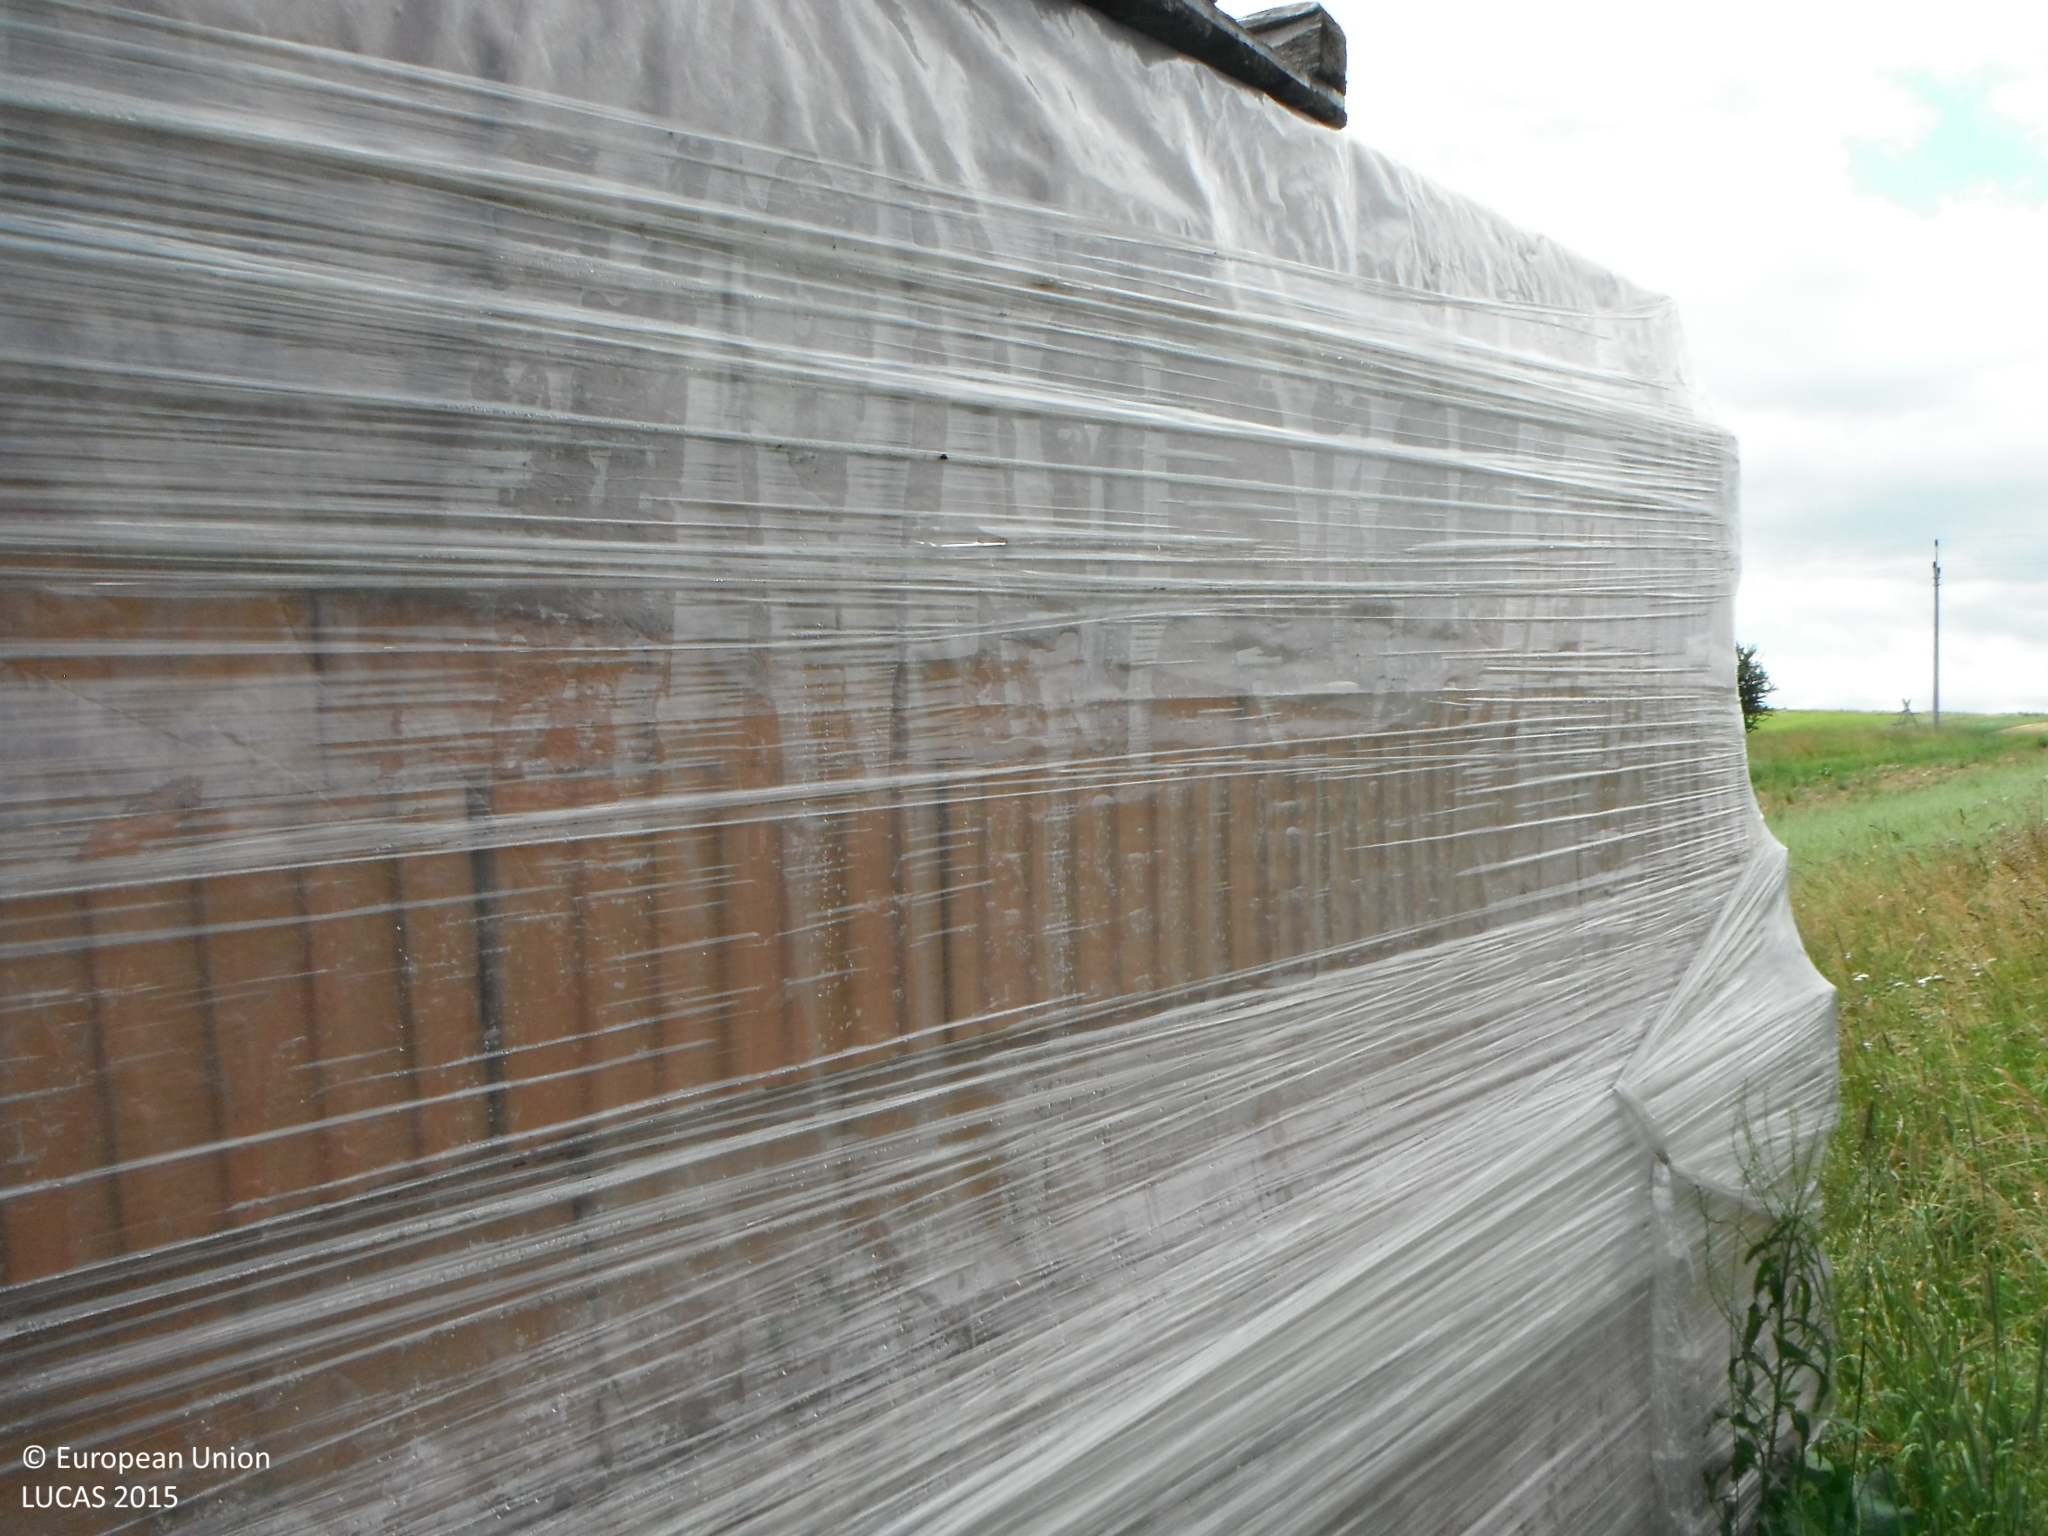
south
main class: Grassland
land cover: Grassland without tree/shrub cover
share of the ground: > 75 %
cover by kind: herbaceous plants 100 %
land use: Agriculture (excluding fallow land and kitchen gardens)
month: July
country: SK
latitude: 49.4449
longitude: 19.4742
